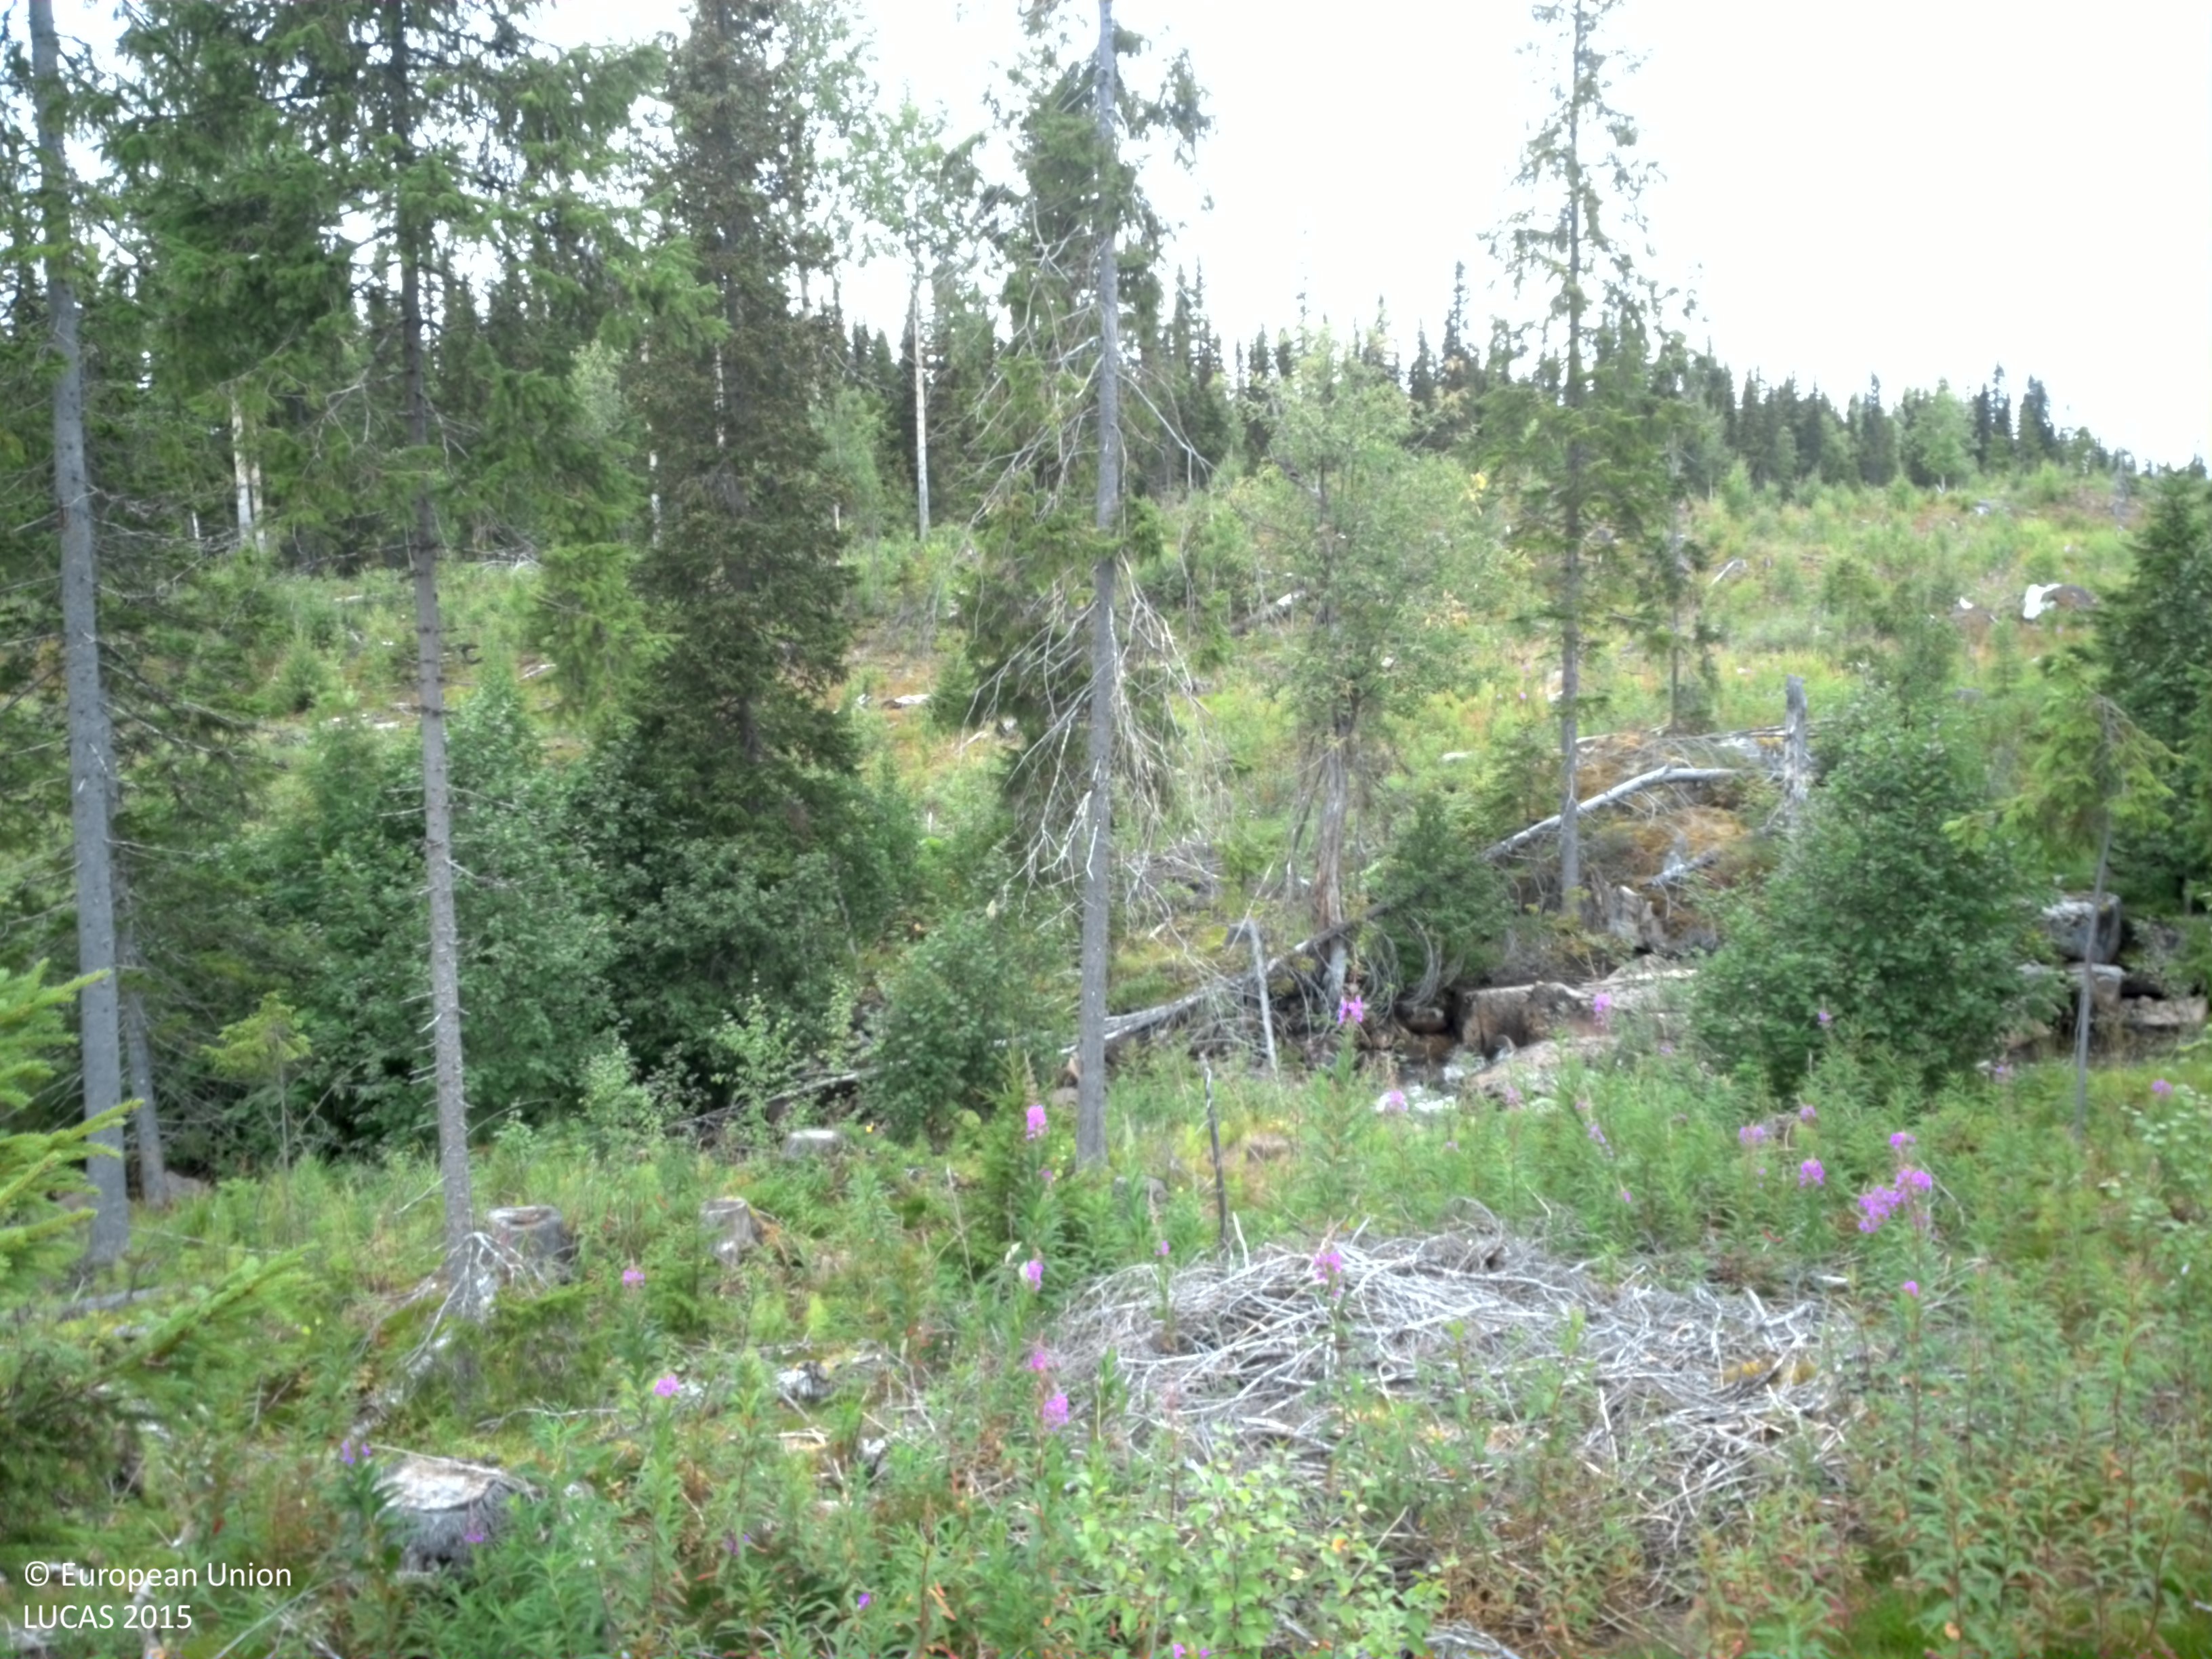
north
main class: Grassland
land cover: Grassland with sparse tree/shrub cover
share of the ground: > 75 %
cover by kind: herbaceous plants 80 %, broadleaved forest trees 5 %, shrubs 5 %, lichens and mosses 5 %
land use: Forestry
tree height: < 5 m
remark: Clear cut
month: August
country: SE
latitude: 64.7869
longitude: 16.5933
